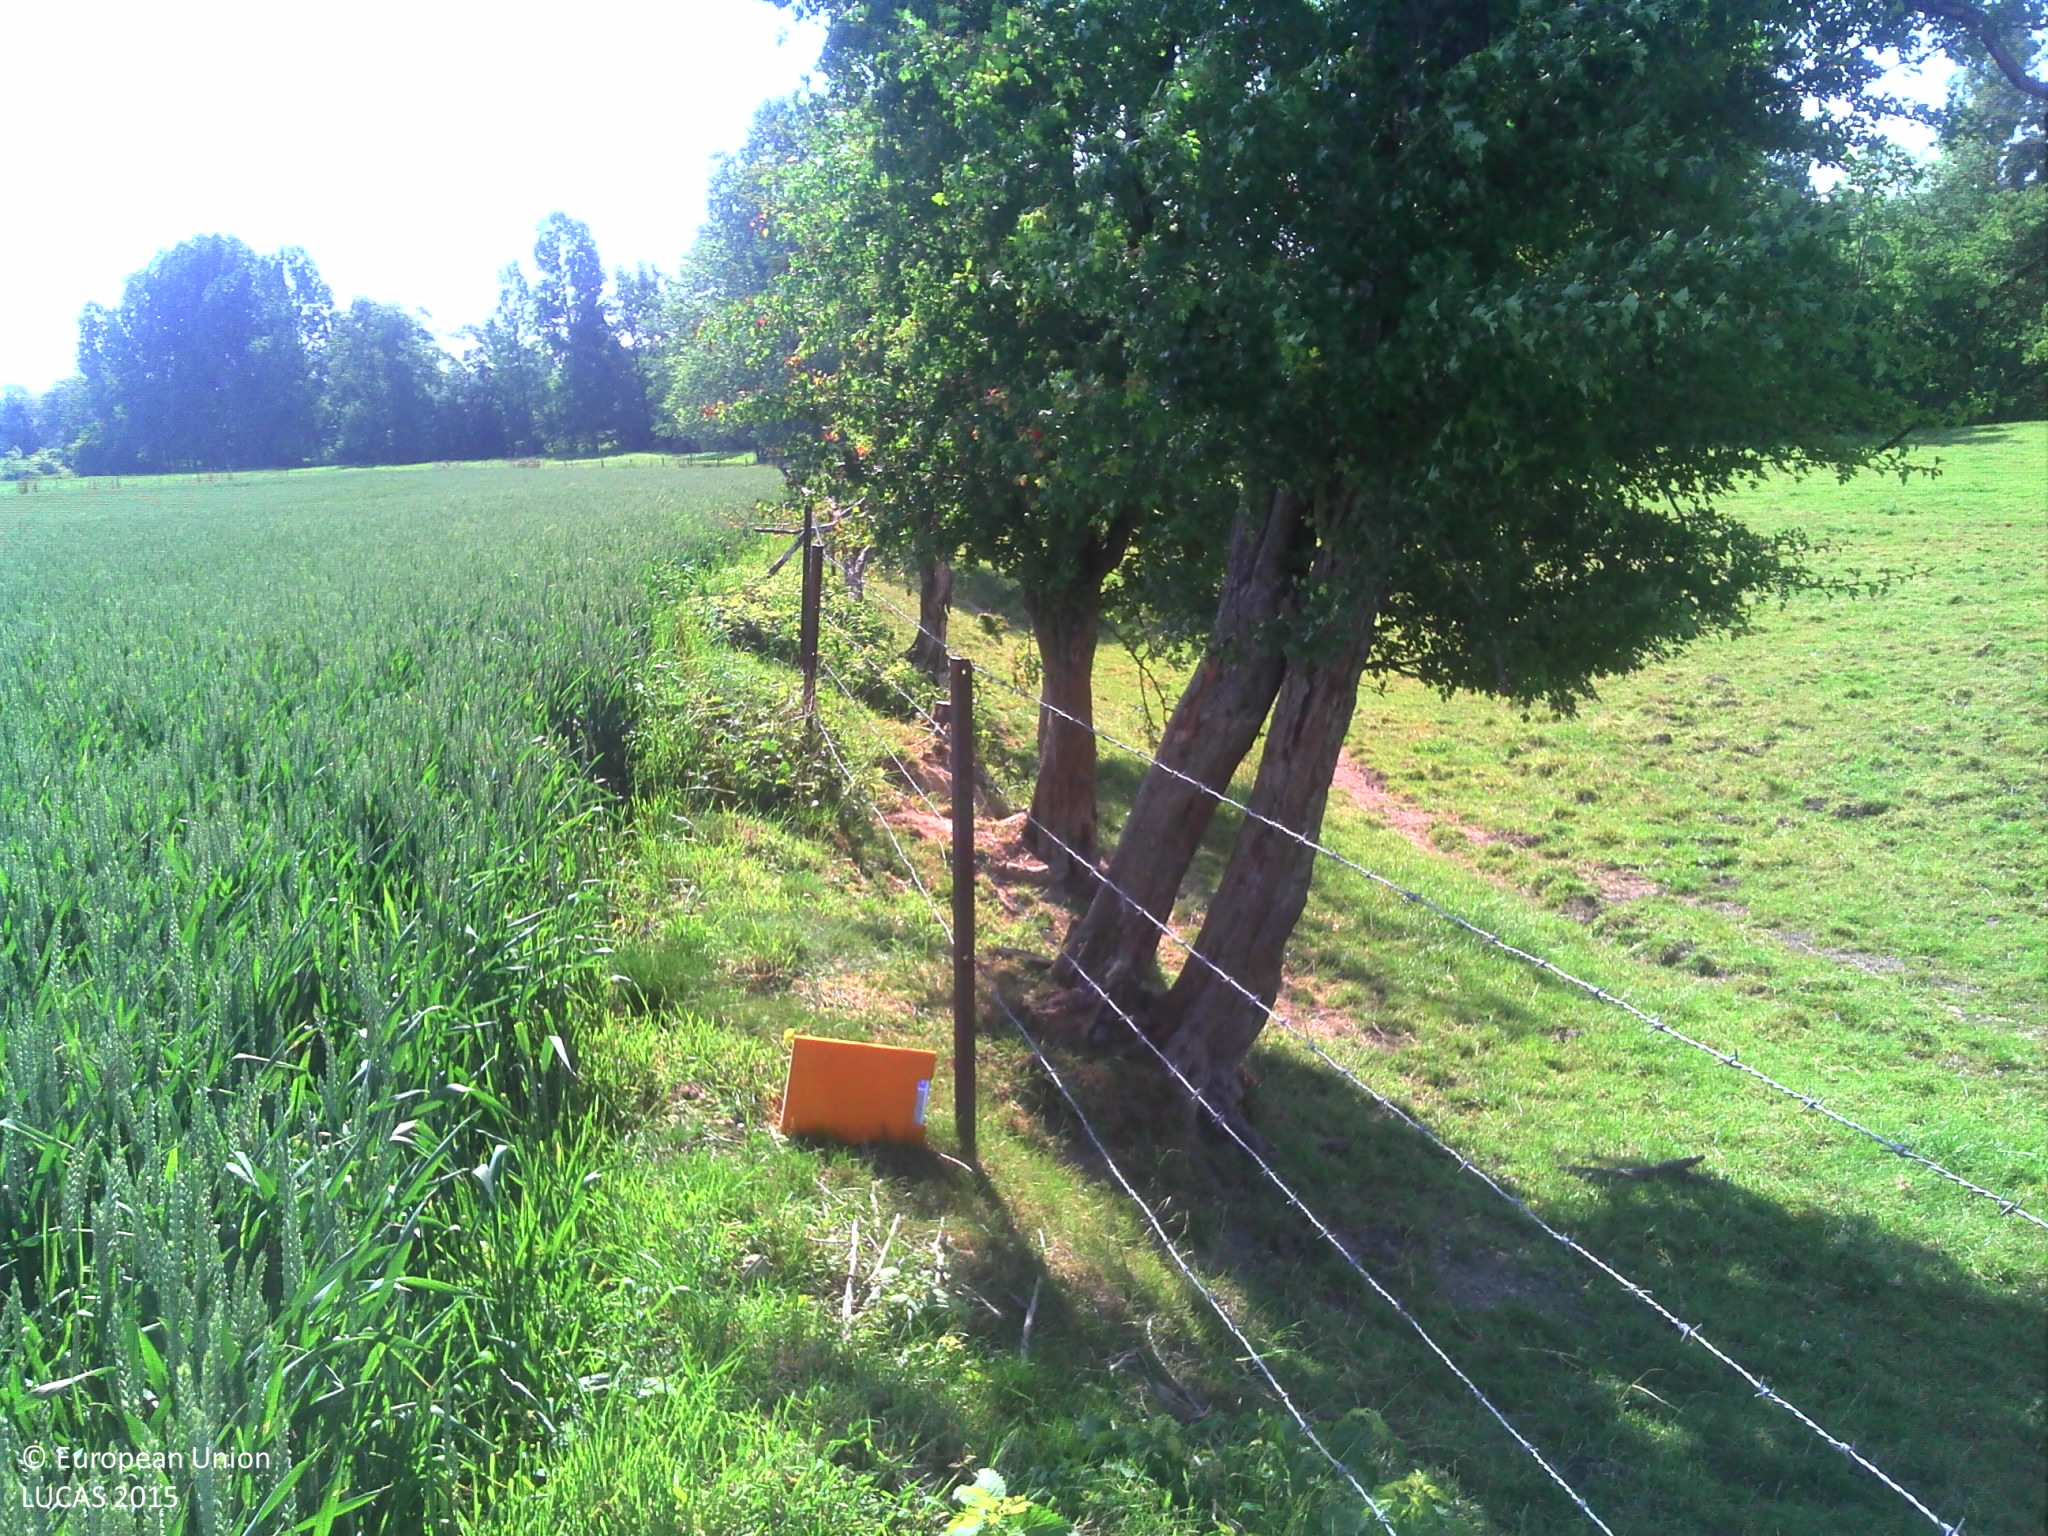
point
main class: Cropland
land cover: Common wheat
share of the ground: > 75 %
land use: Agriculture (excluding fallow land and kitchen gardens)
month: June
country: FR
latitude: 49.7758
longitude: 4.0374
